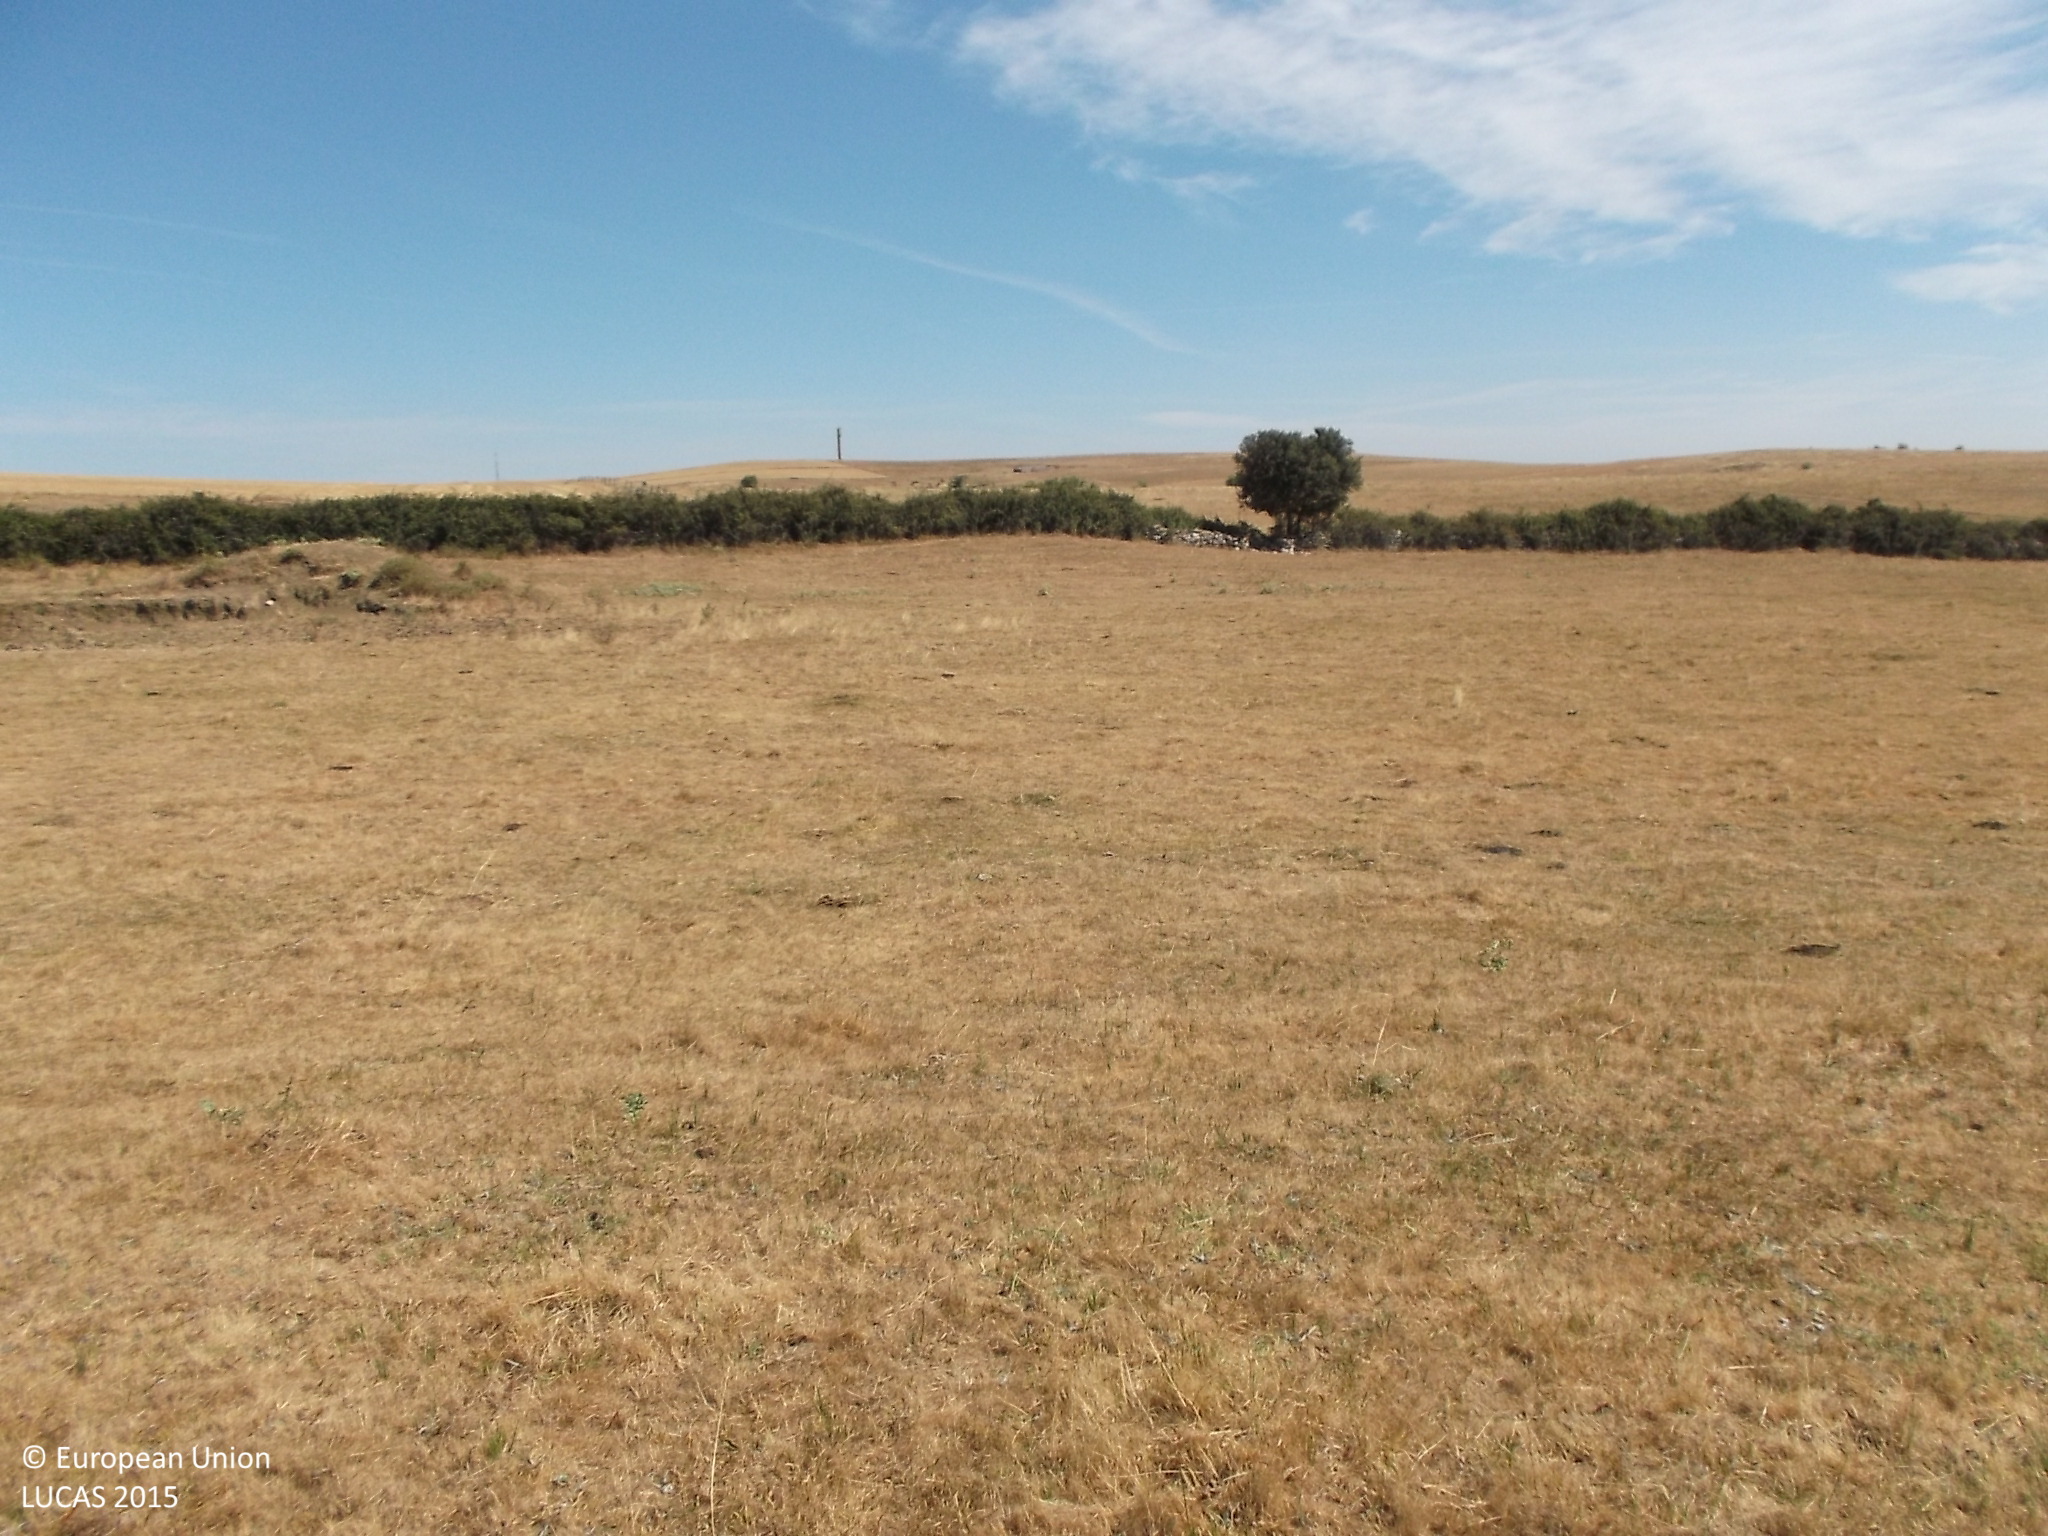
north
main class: Grassland
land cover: Grassland without tree/shrub cover
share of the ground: > 75 %
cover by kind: herbaceous plants 100 %
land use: Agriculture (excluding fallow land and kitchen gardens)
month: July
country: ES
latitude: 40.6860
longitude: -6.6958
